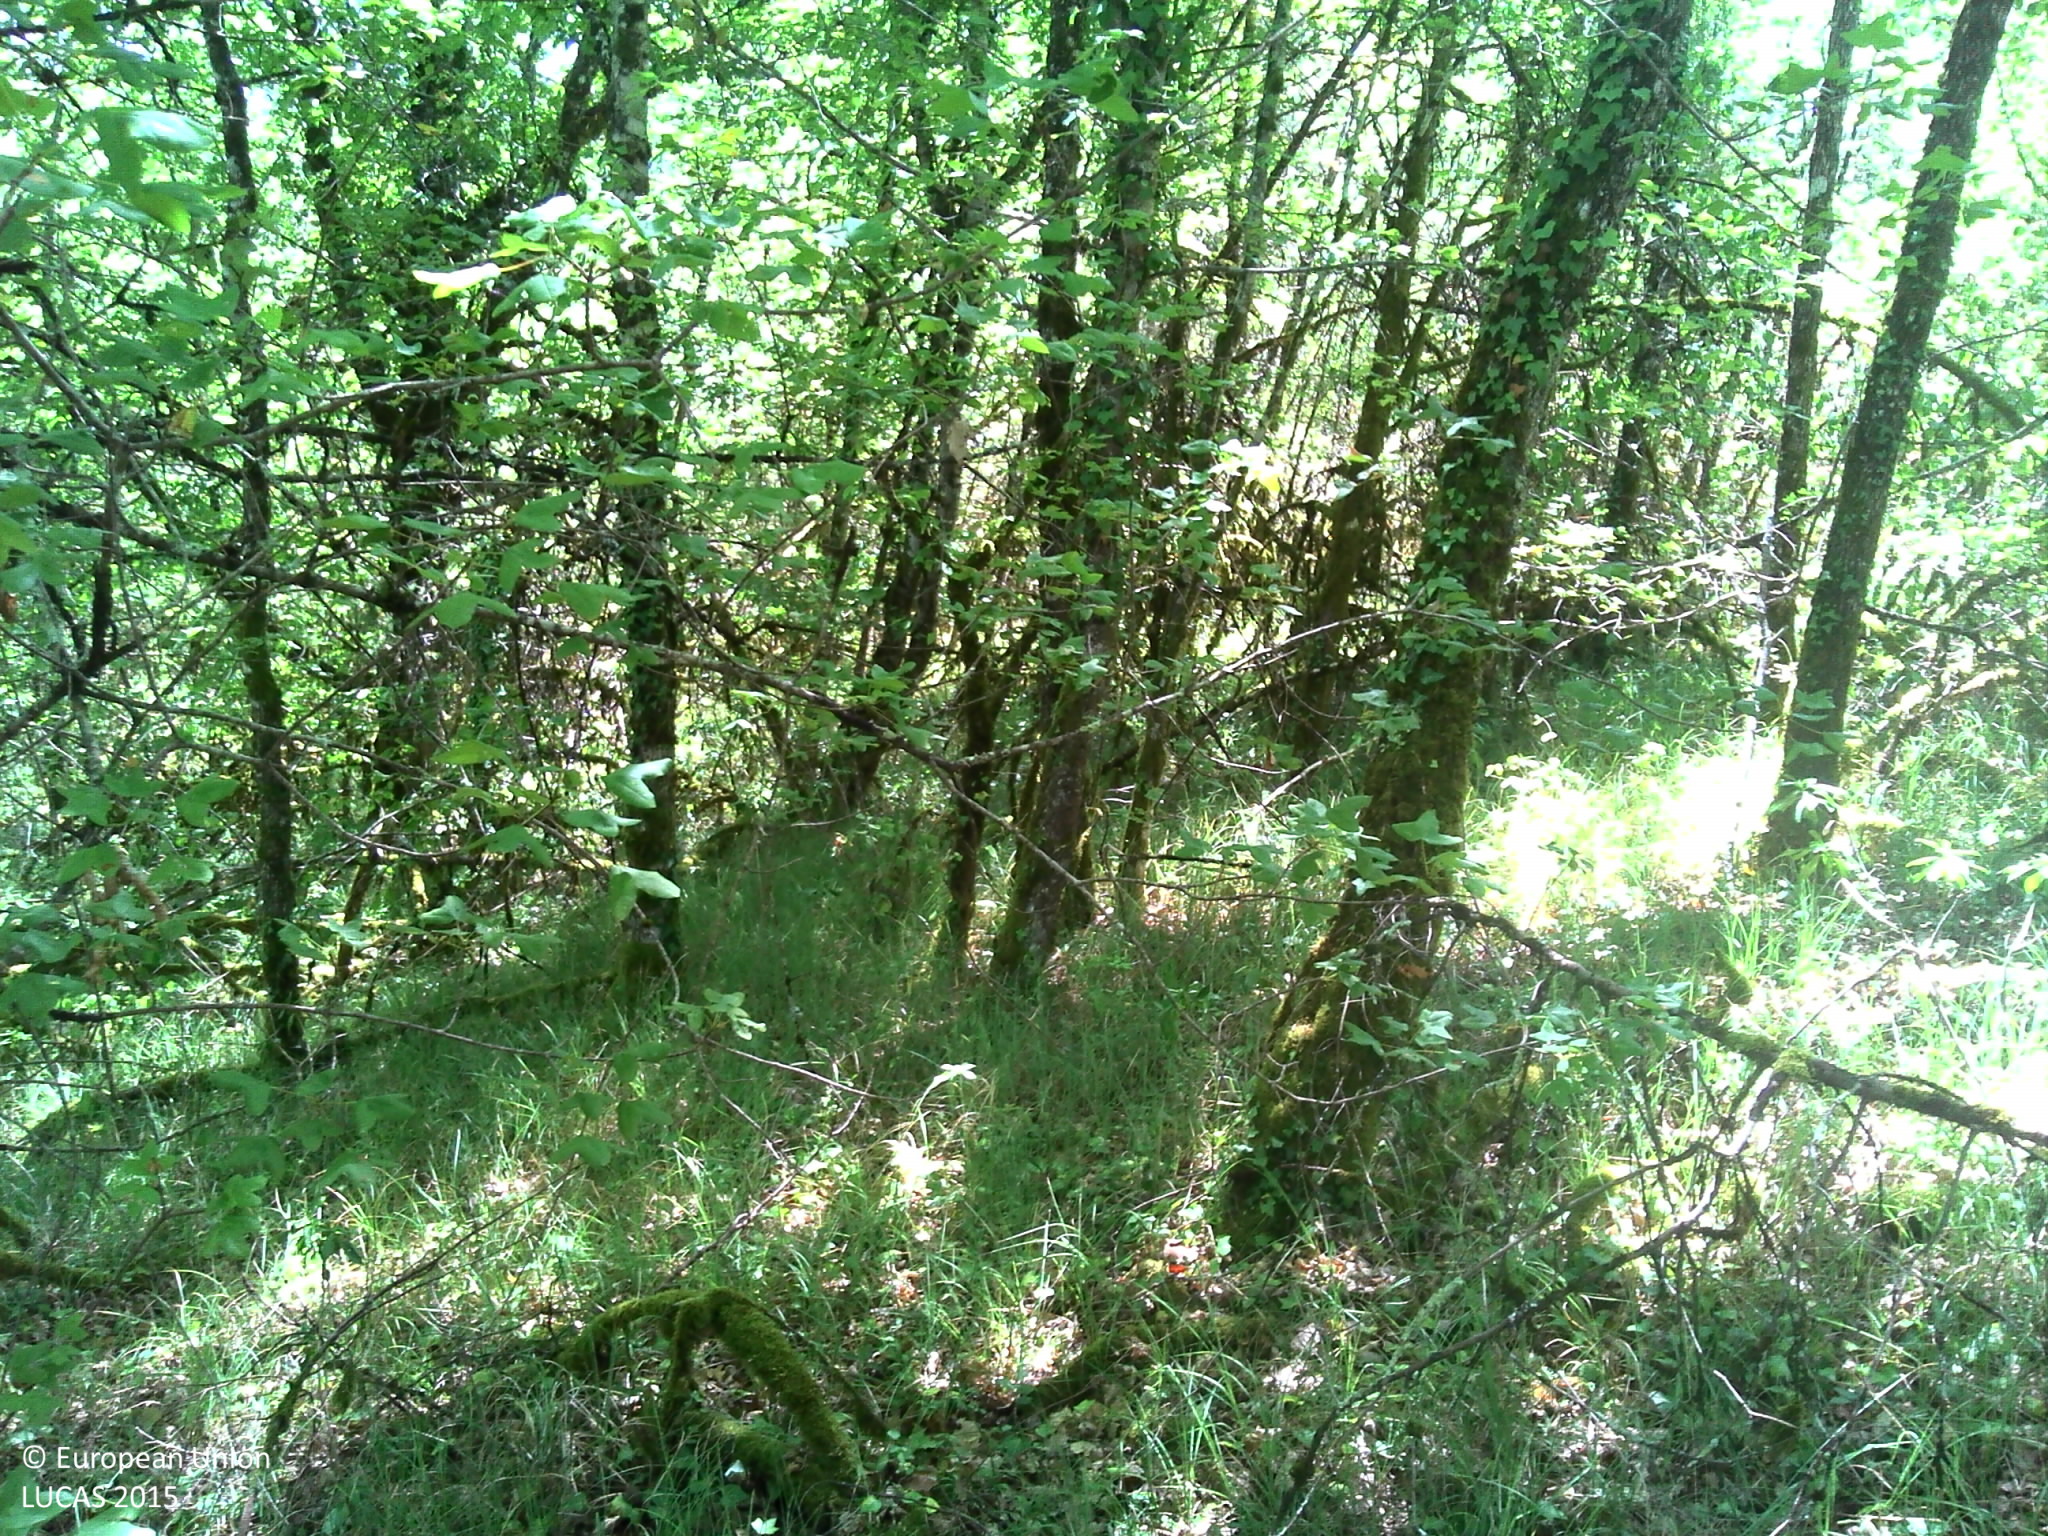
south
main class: Woodland
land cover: Broadleaved woodland
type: thermophilous deciduous forest
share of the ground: > 75 %
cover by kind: broadleaved forest trees 95 %, herbaceous plants 5 %
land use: Forestry
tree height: > 5 m
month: July
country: FR
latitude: 44.6071
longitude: 1.5939
